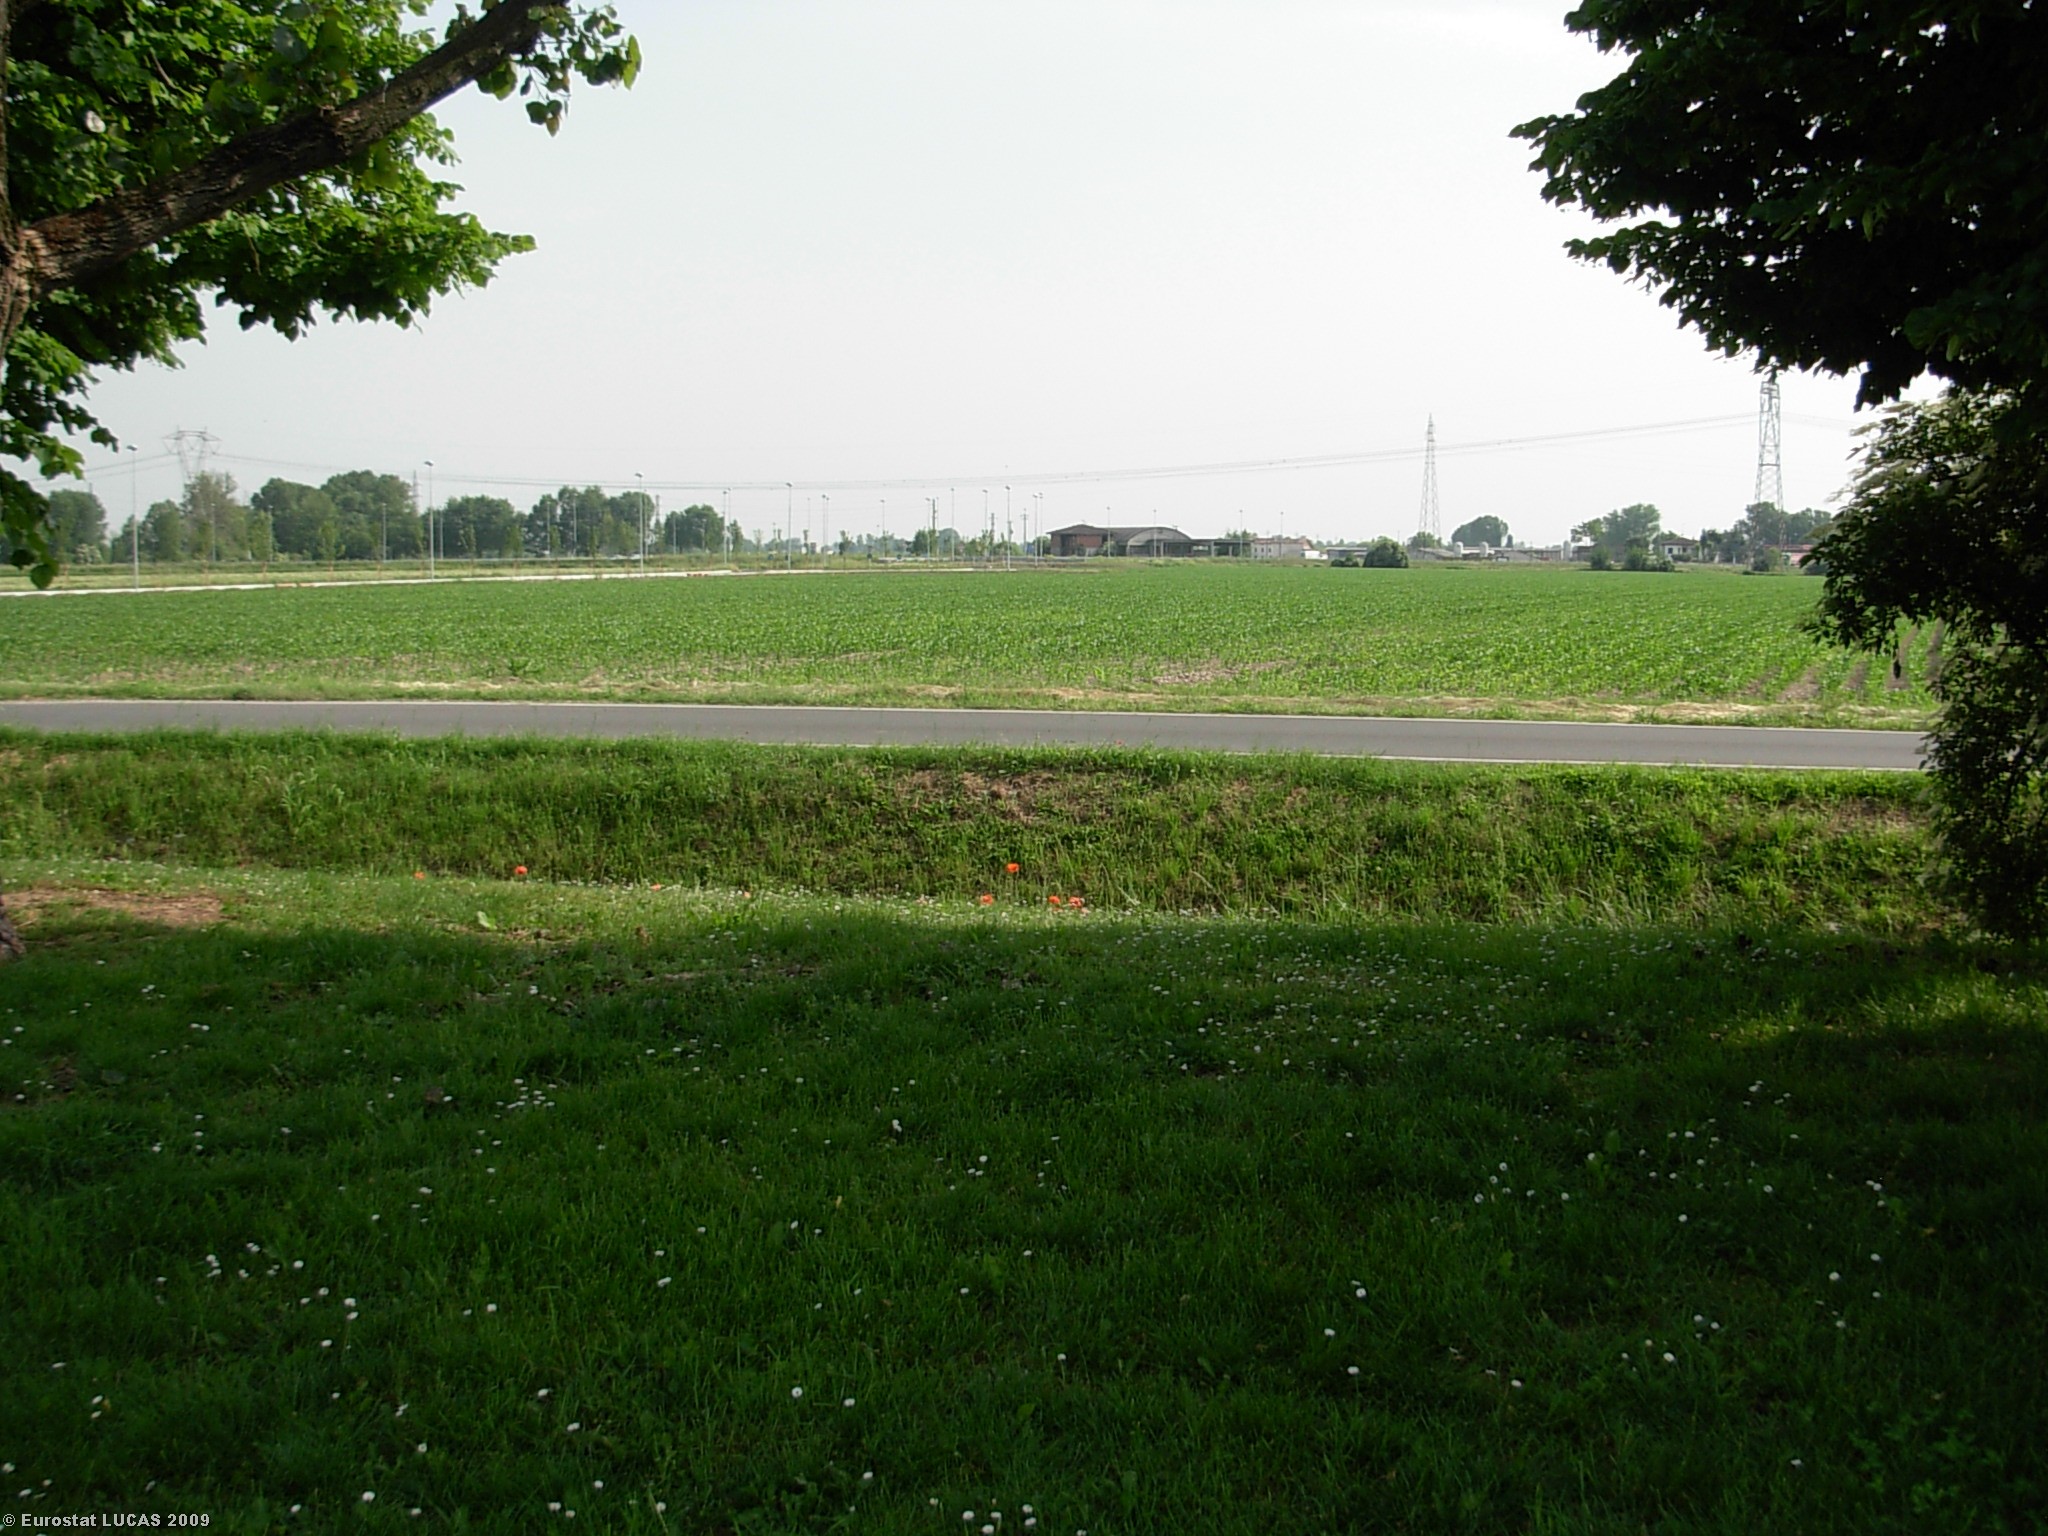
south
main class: Woodland
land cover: Broadleaved woodland
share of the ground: > 75 %
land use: Community services
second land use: Amenities, museums, leisure
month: May
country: IT
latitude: 45.3959
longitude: 10.2678
